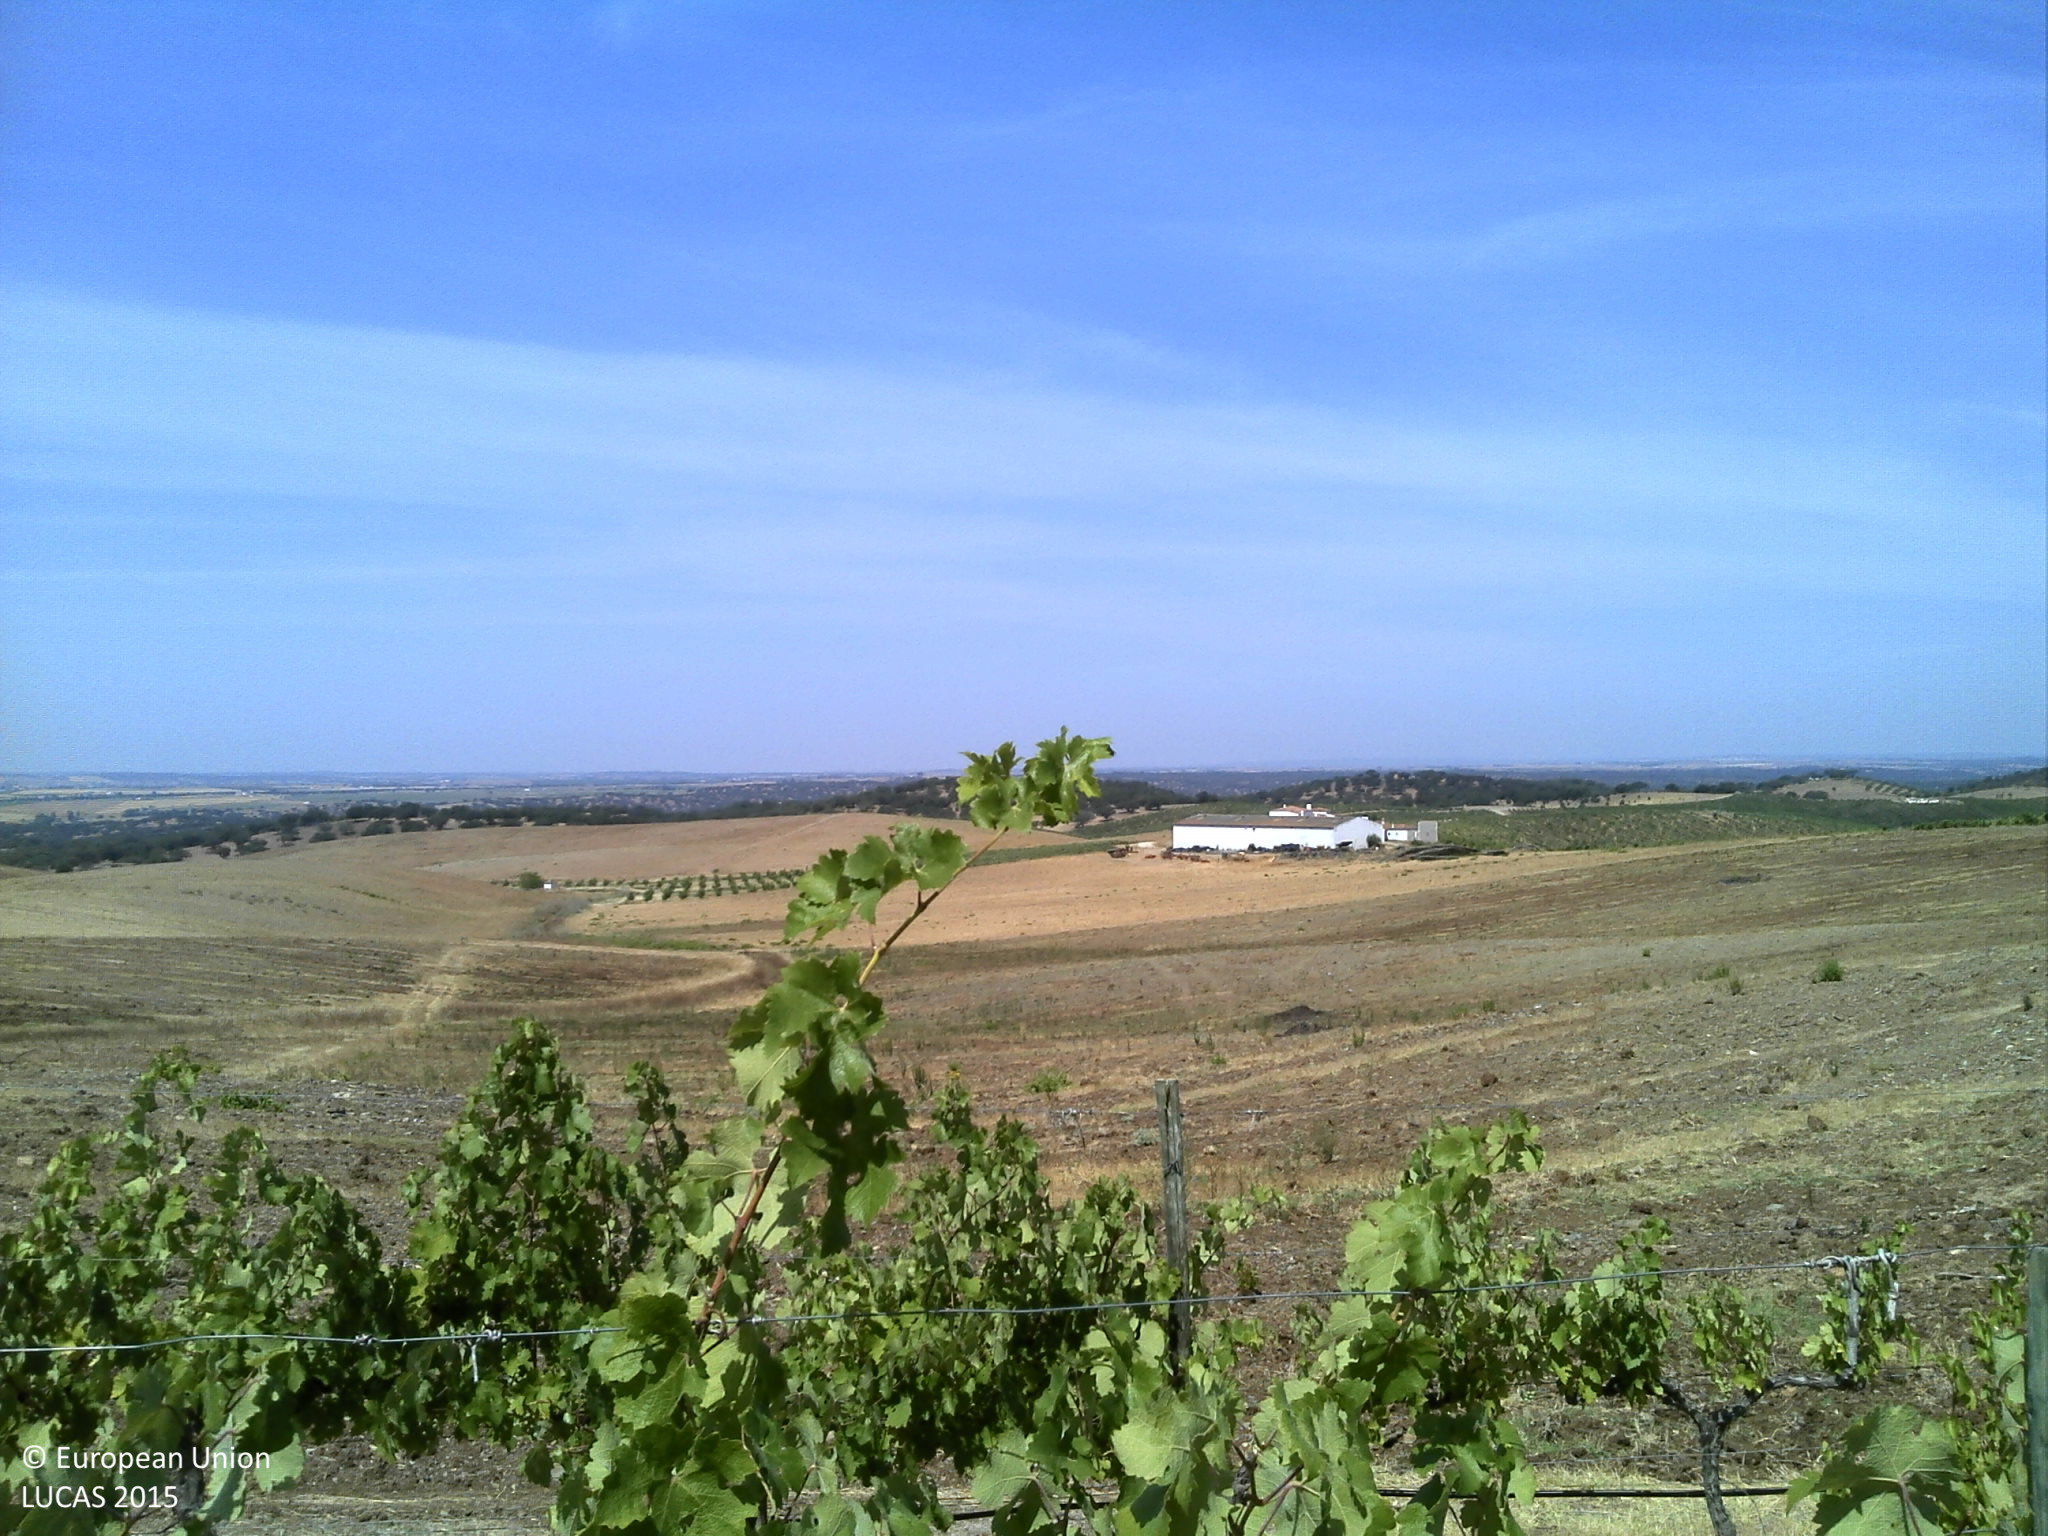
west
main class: Cropland
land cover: Vineyards
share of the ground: 25 - 50 %
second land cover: Grassland without tree/shrub cover
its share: 25 - 50 %
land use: Agriculture (excluding fallow land and kitchen gardens)
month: July
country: PT
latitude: 38.5037
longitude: -7.6570
